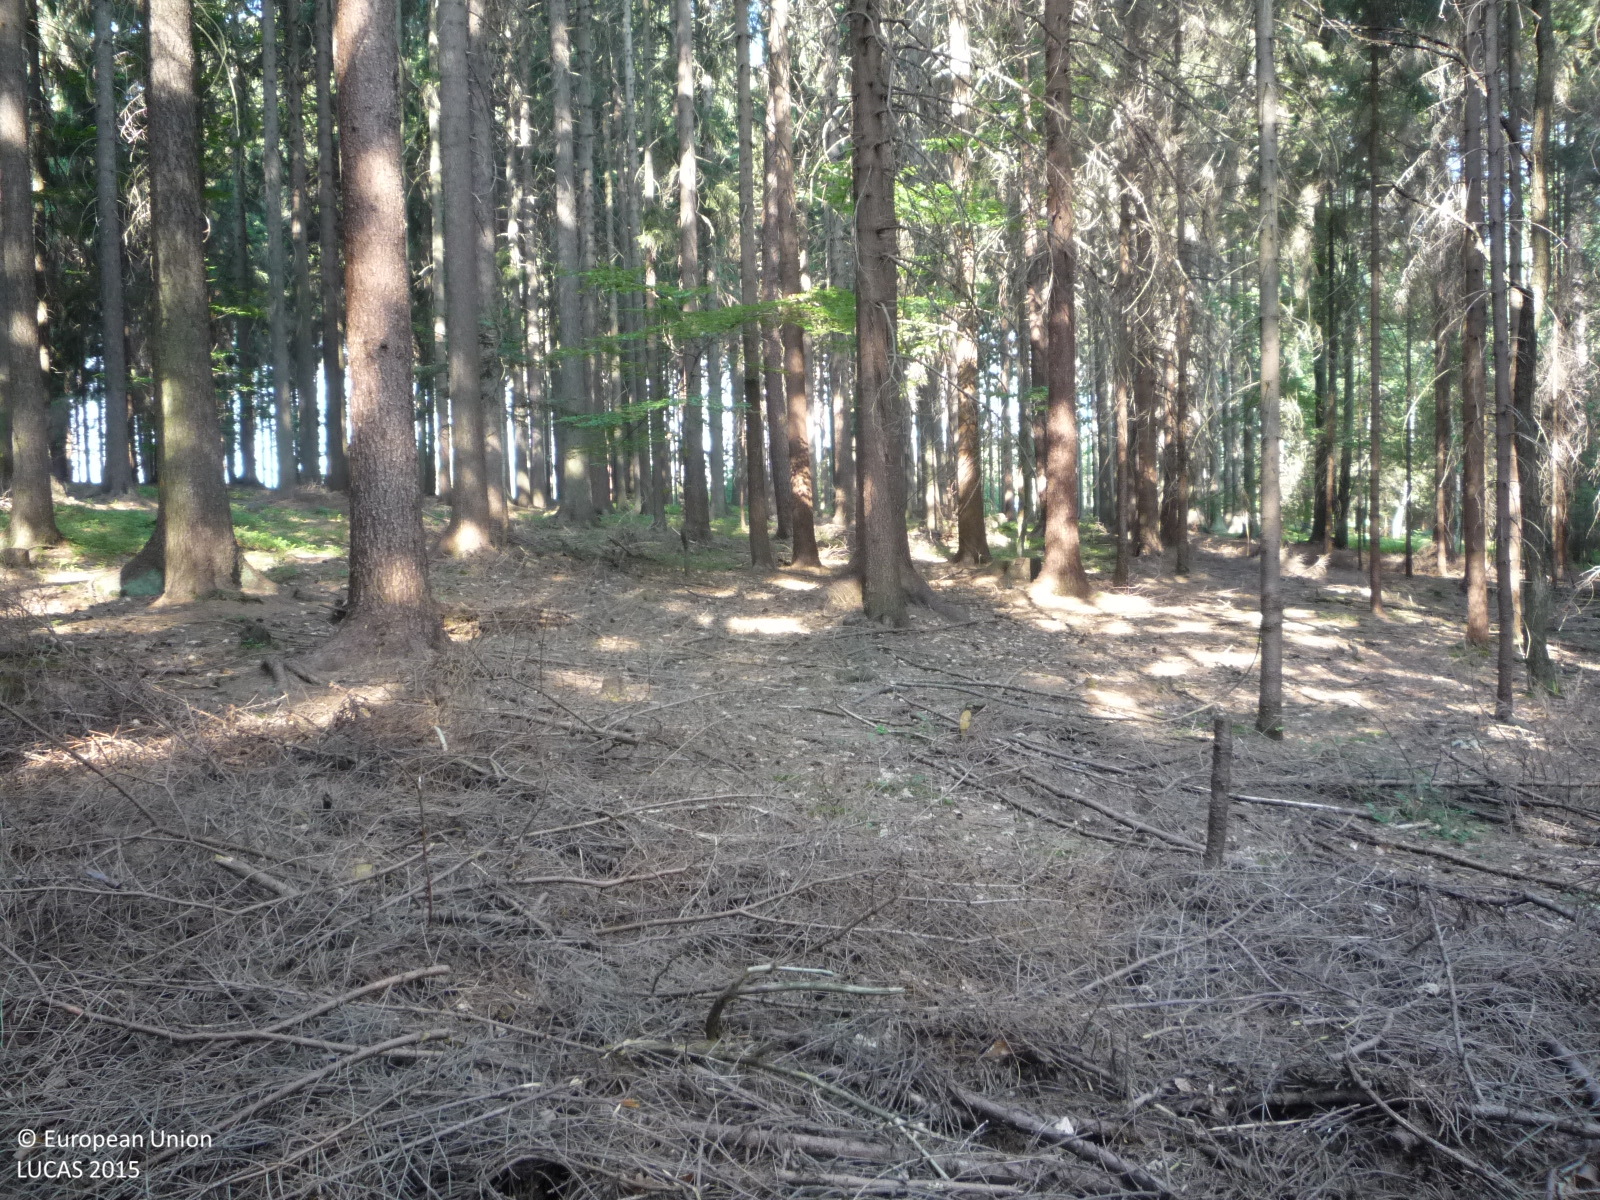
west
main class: Woodland
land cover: Spruce dominated coniferous woodland
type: hemiboreal forest and nemoral coniferous forest and mixed broadleaved-coniferous forest
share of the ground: > 75 %
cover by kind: coniferous forest trees 90 %, shrubs 5 %, unconsolidated bare surface 5 %
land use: Forestry
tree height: > 5 m
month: August
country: CZ
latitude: 50.6938
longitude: 15.2556
